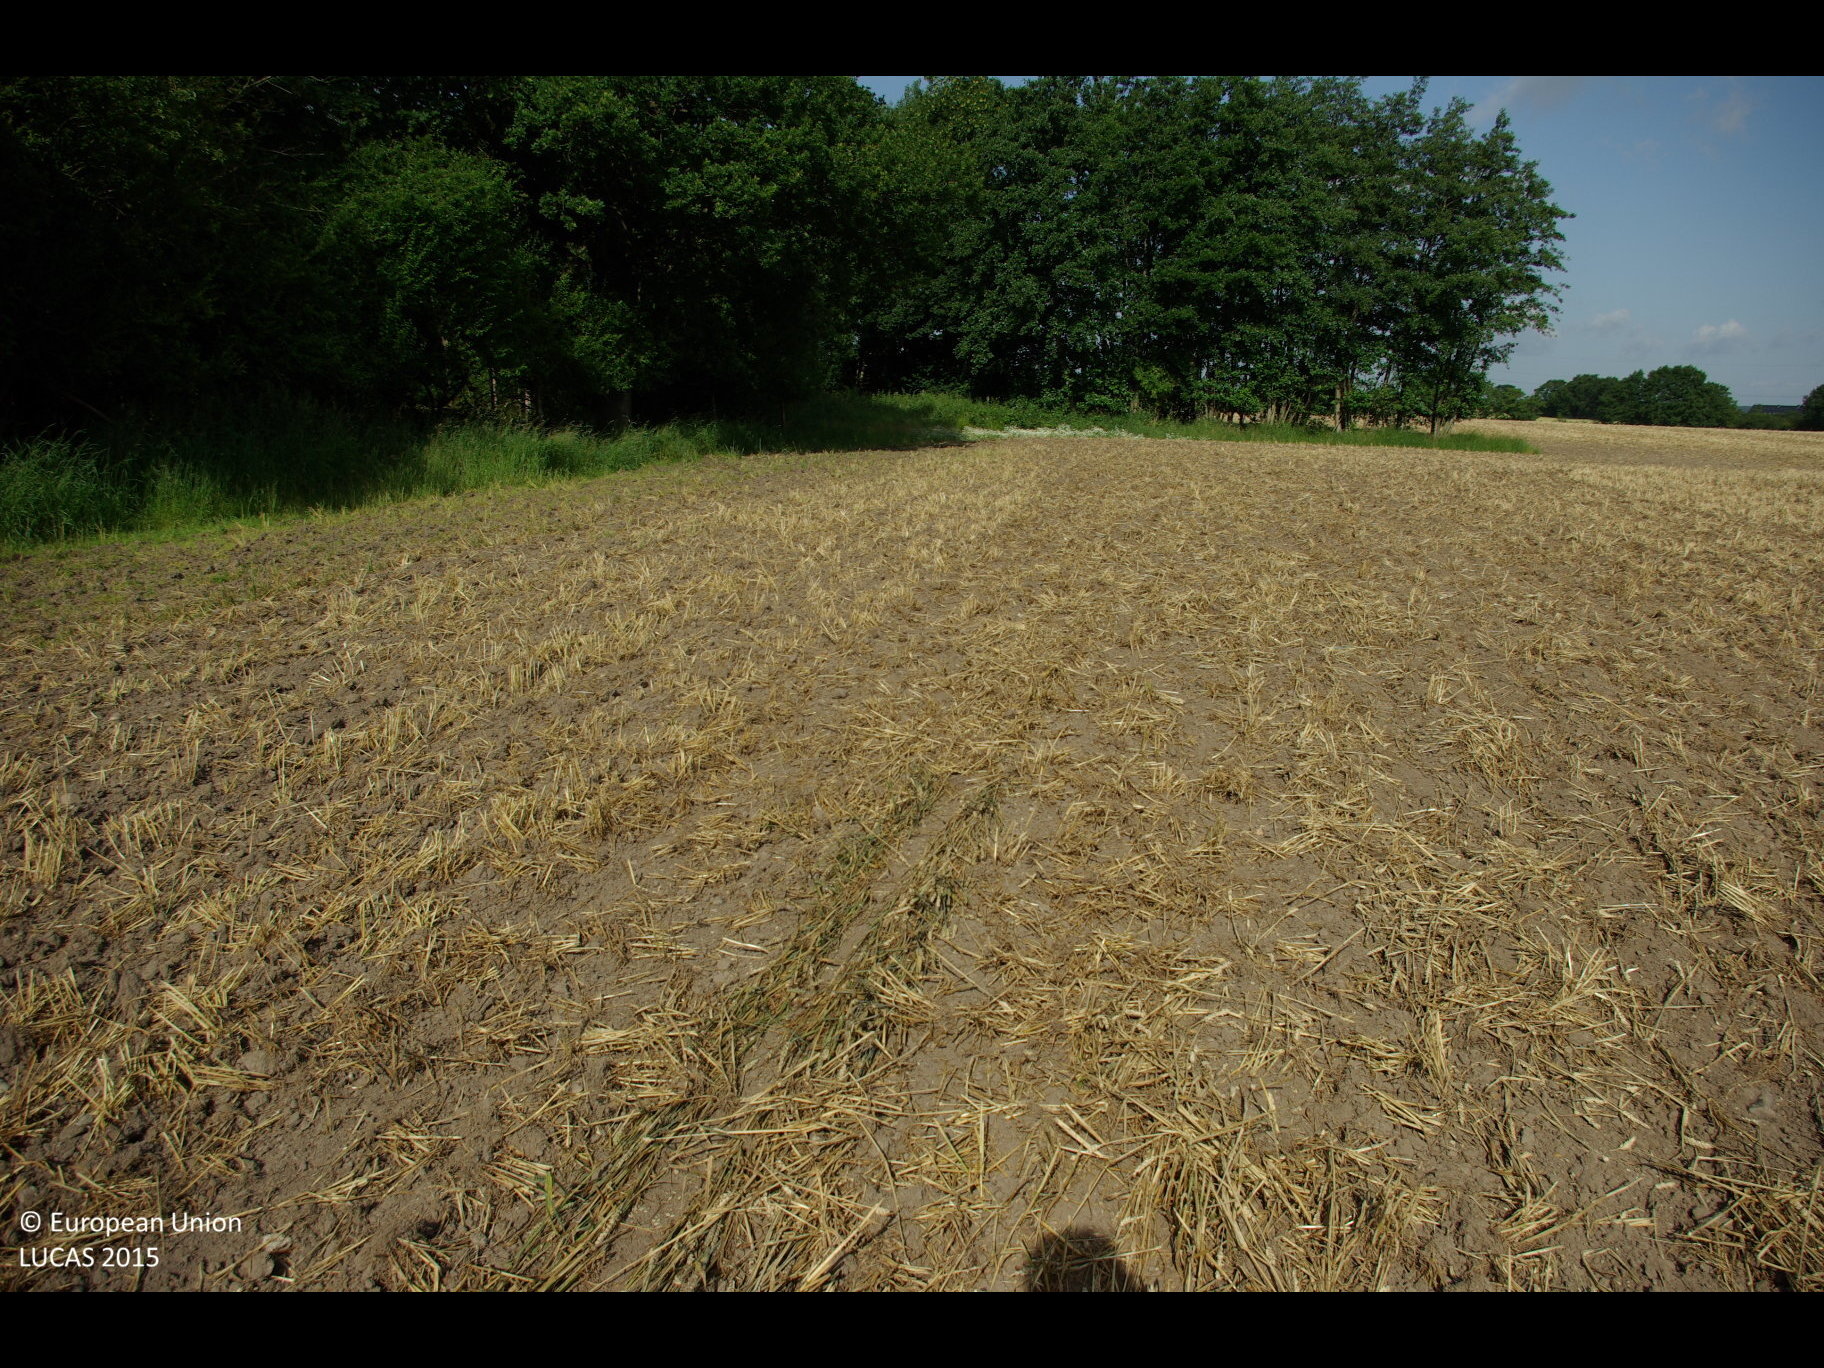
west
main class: Cropland
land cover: Common wheat
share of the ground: < 10 %
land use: Agriculture (excluding fallow land and kitchen gardens)
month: July
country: DE
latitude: 54.6060
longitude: 9.9536
